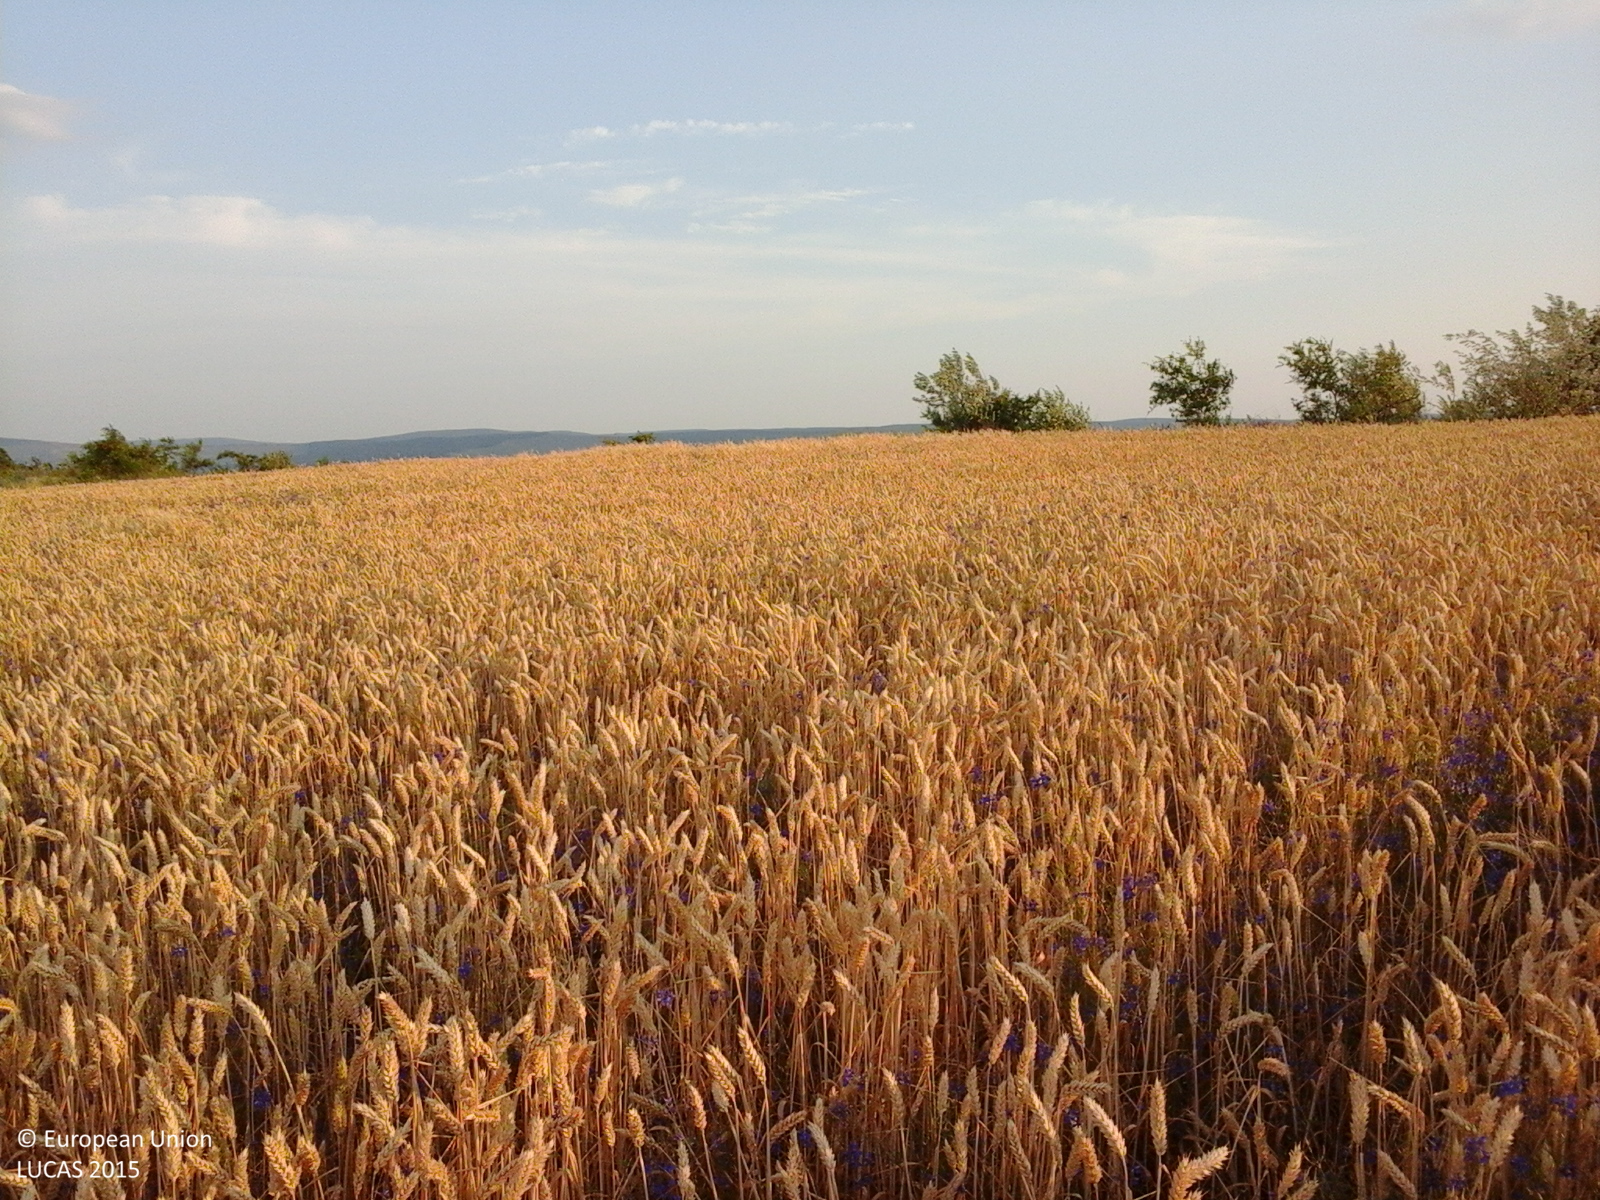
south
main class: Cropland
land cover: Common wheat
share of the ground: > 75 %
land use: Agriculture (excluding fallow land and kitchen gardens)
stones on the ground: < 10 %
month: June
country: RO
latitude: 47.1560
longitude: 27.4042
